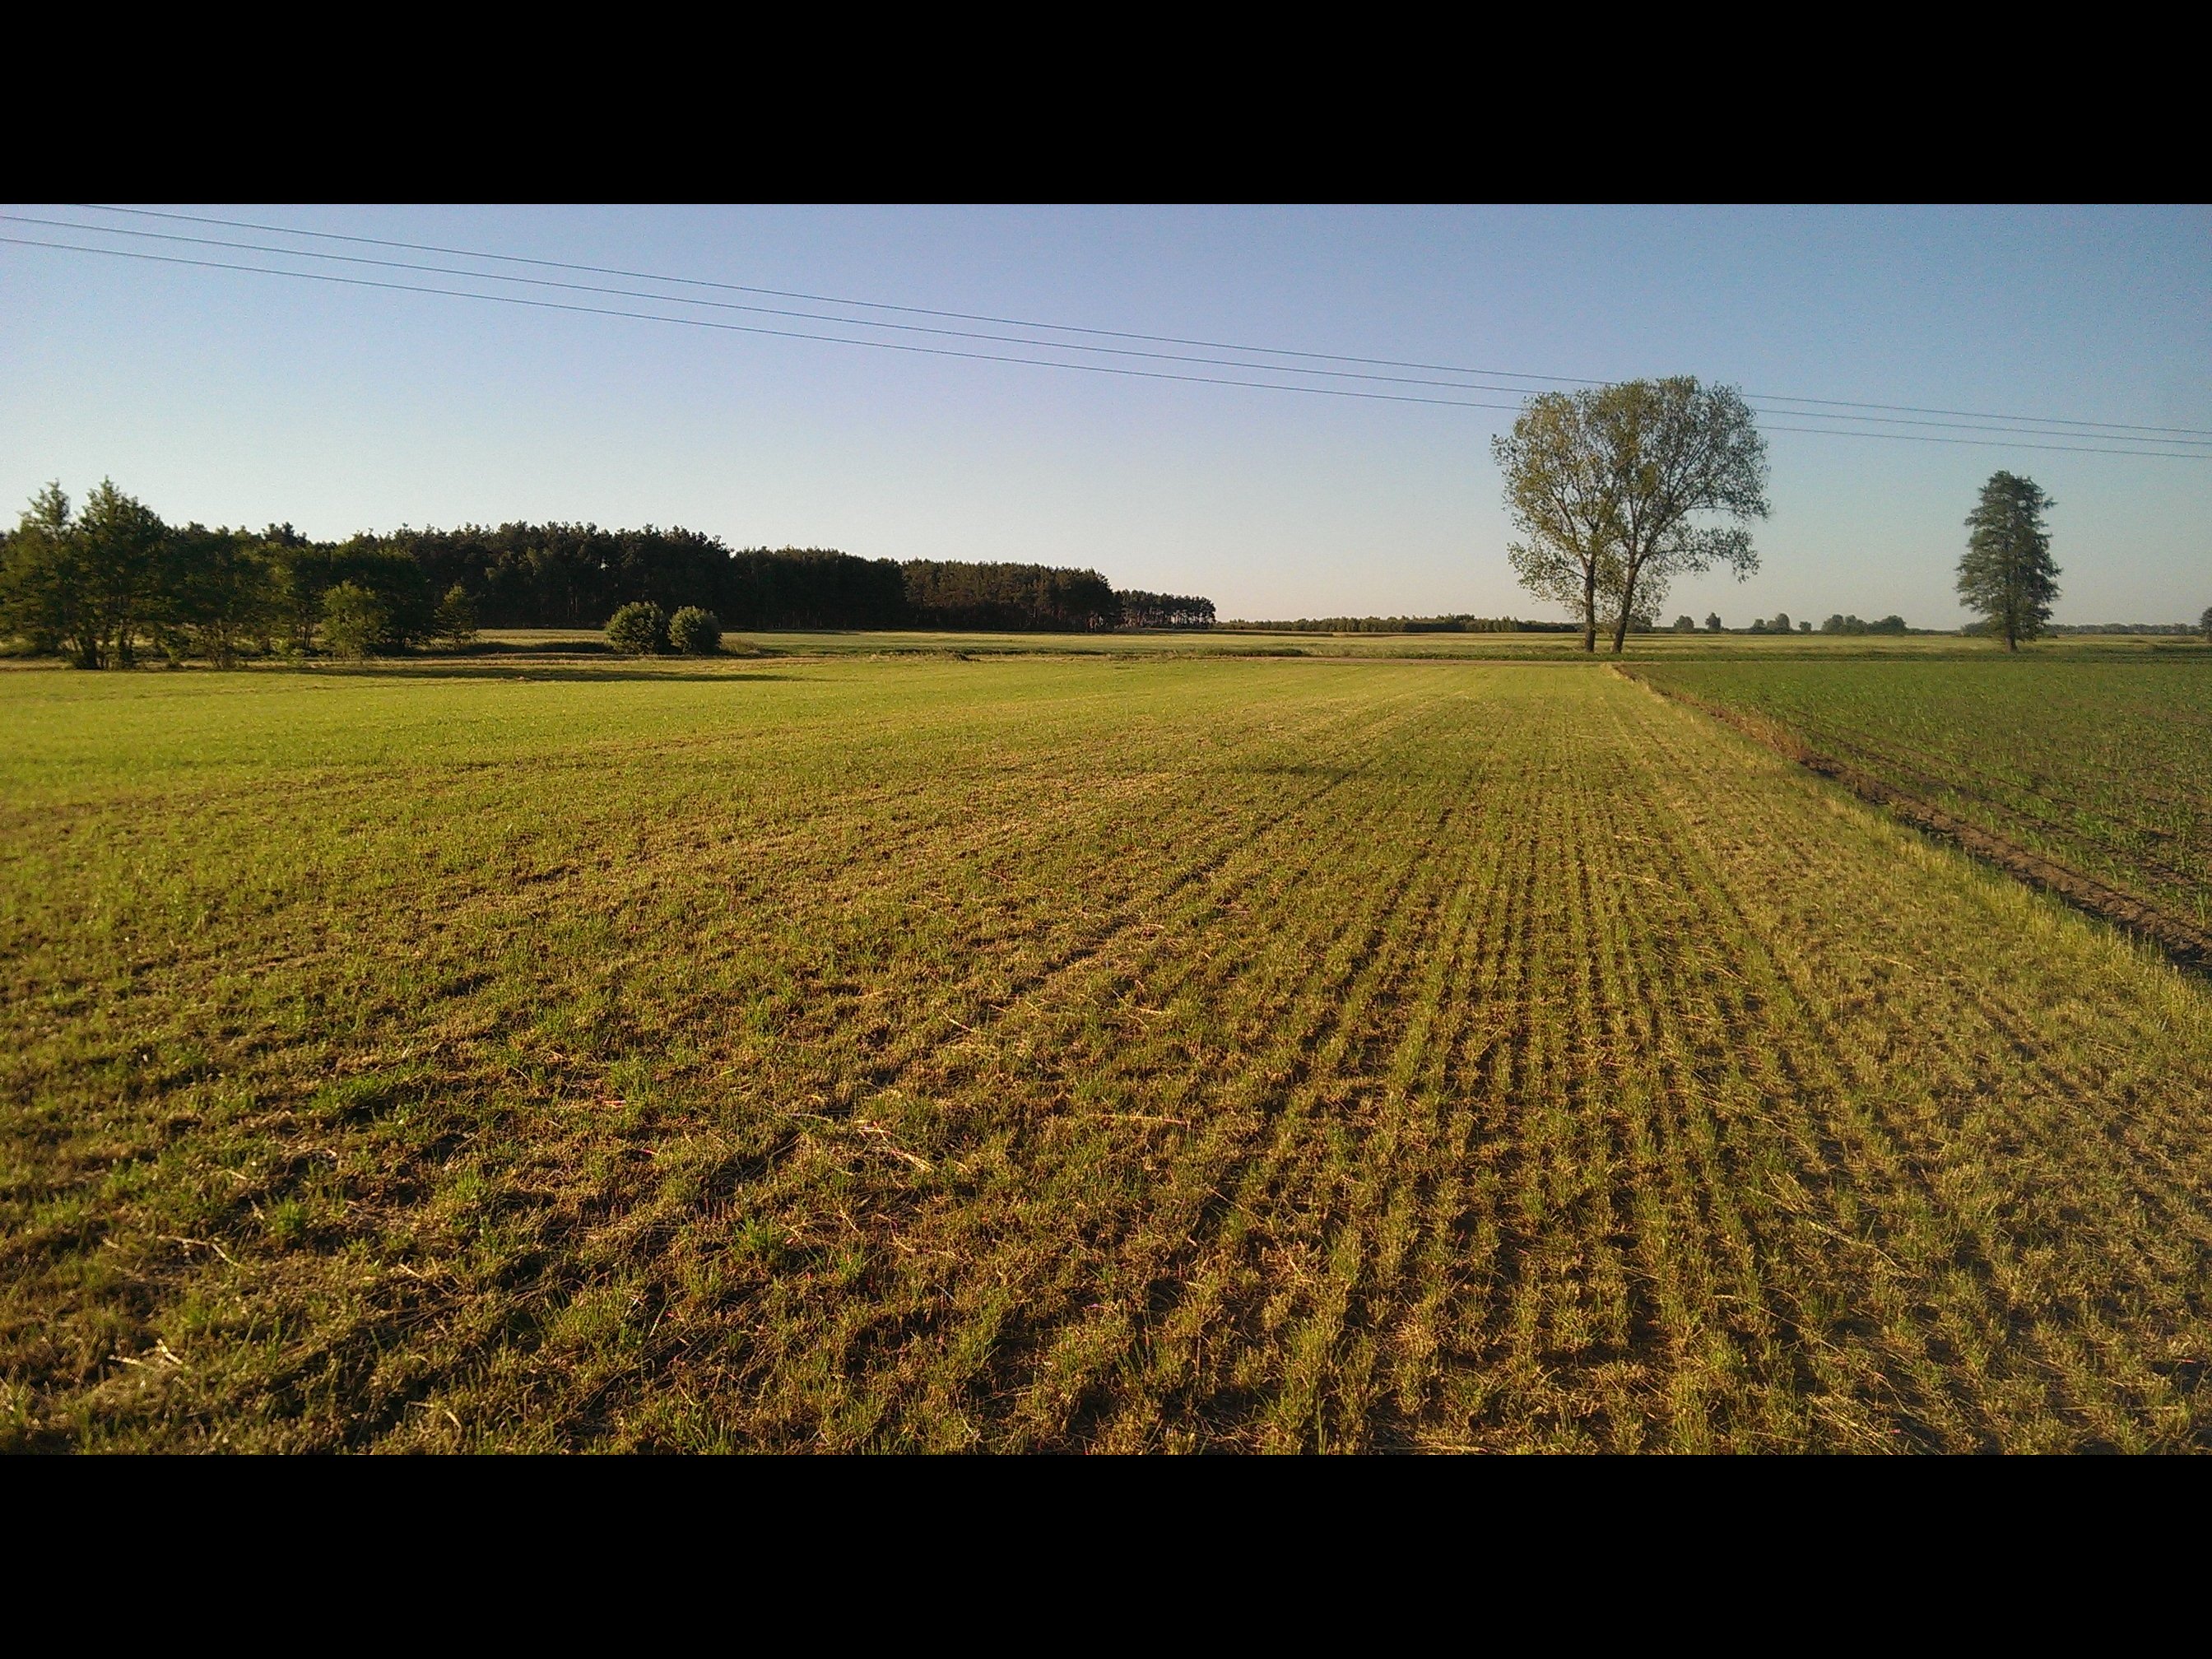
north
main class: Cropland
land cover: Temporary grasslands
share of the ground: > 75 %
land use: Agriculture (excluding fallow land and kitchen gardens)
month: June
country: PL
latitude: 51.9113
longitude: 16.1555
